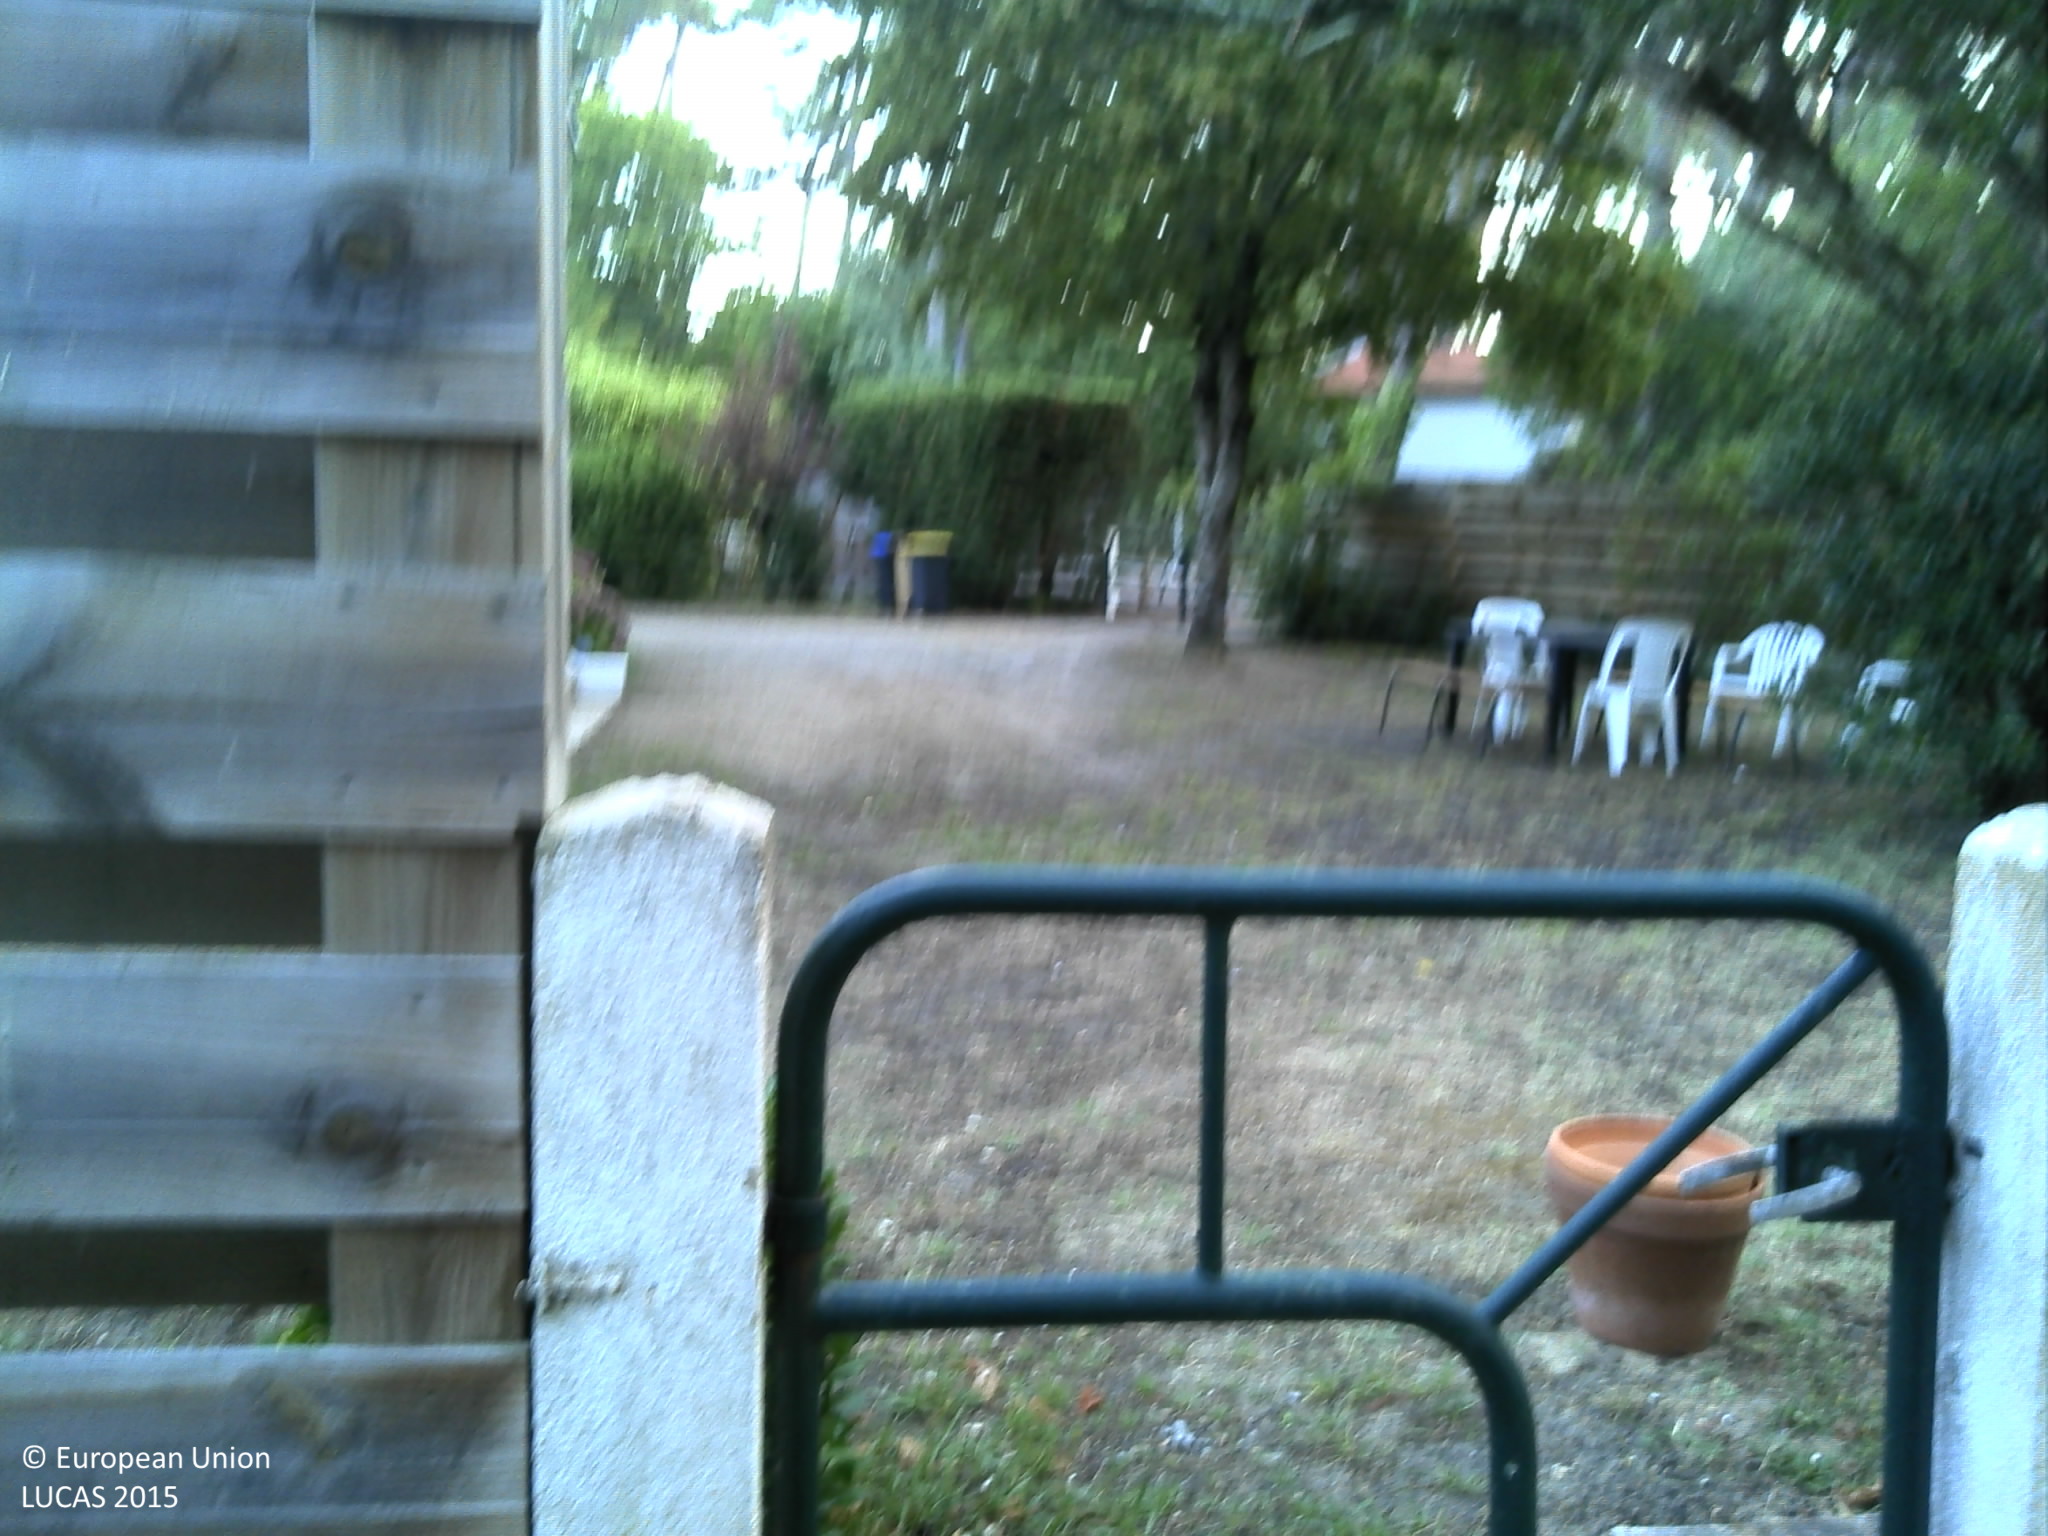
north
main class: Grassland
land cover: Grassland with sparse tree/shrub cover
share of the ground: > 75 %
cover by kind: herbaceous plants 90 %, broadleaved forest trees 5 %, shrubs 5 %
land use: Residential
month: August
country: FR
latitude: 44.7454
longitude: -1.1763
